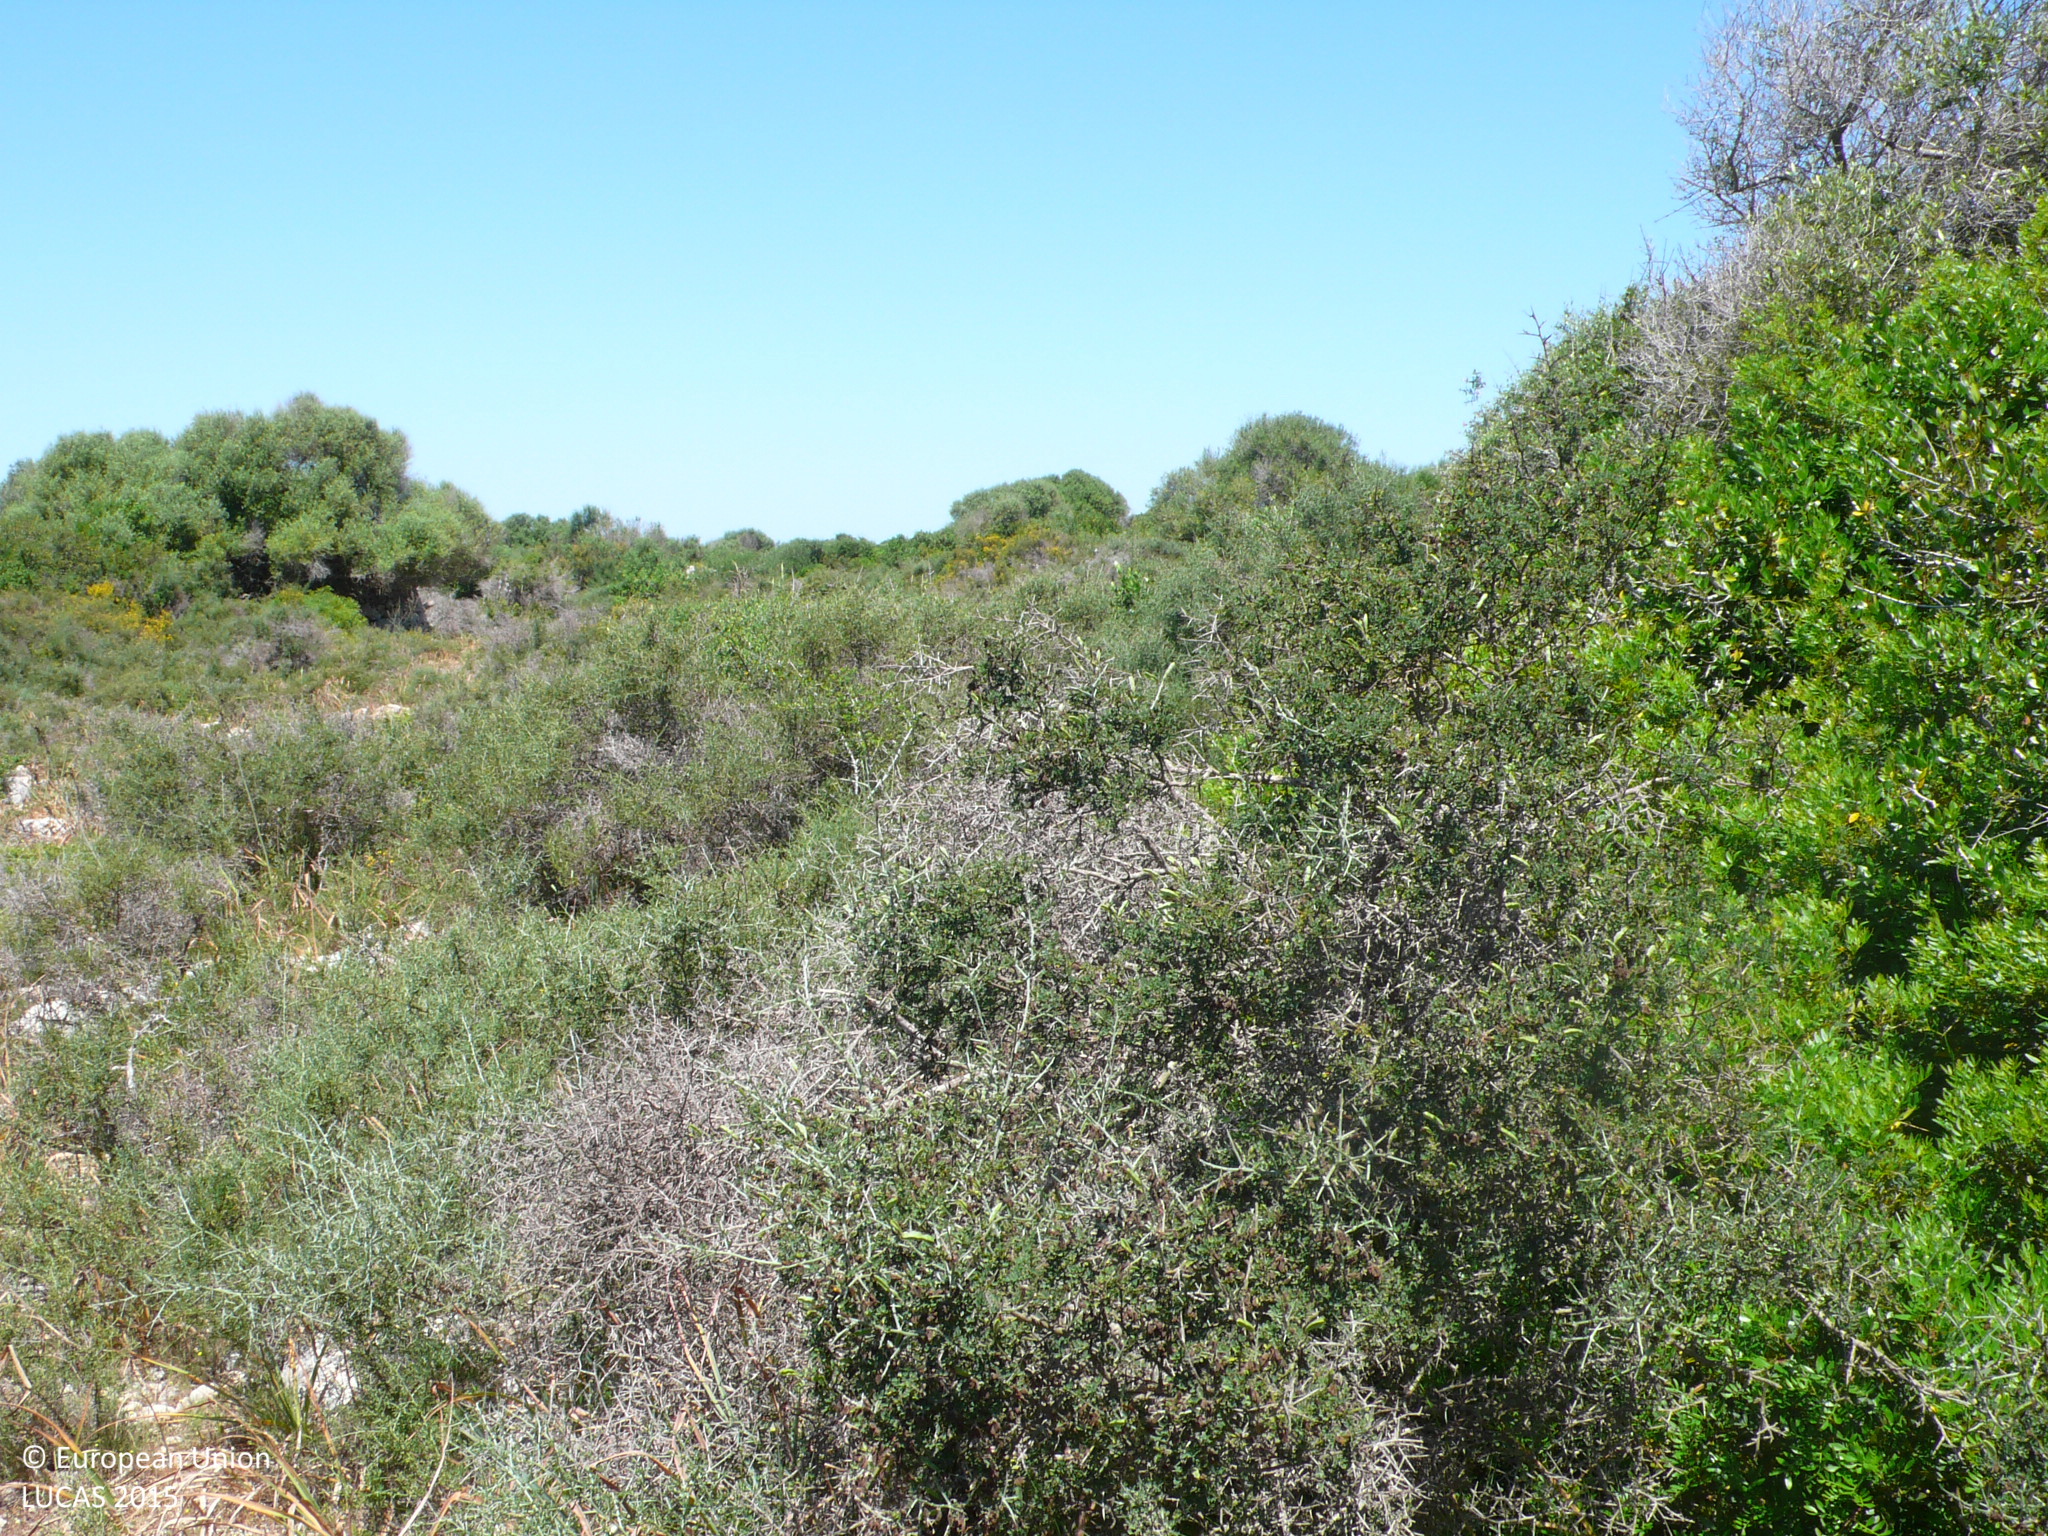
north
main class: Woodland
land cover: Broadleaved woodland
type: broadleaved evergreen forest
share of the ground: 10 - 25 %
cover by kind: shrubs 60 %, broadleaved forest trees 20 %, herbaceous plants 15 %, consolidated bare surface 5 %
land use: Semi-natural and natural areas not in use
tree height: < 5 m
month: May
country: ES
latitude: 39.8260
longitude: 4.2430
